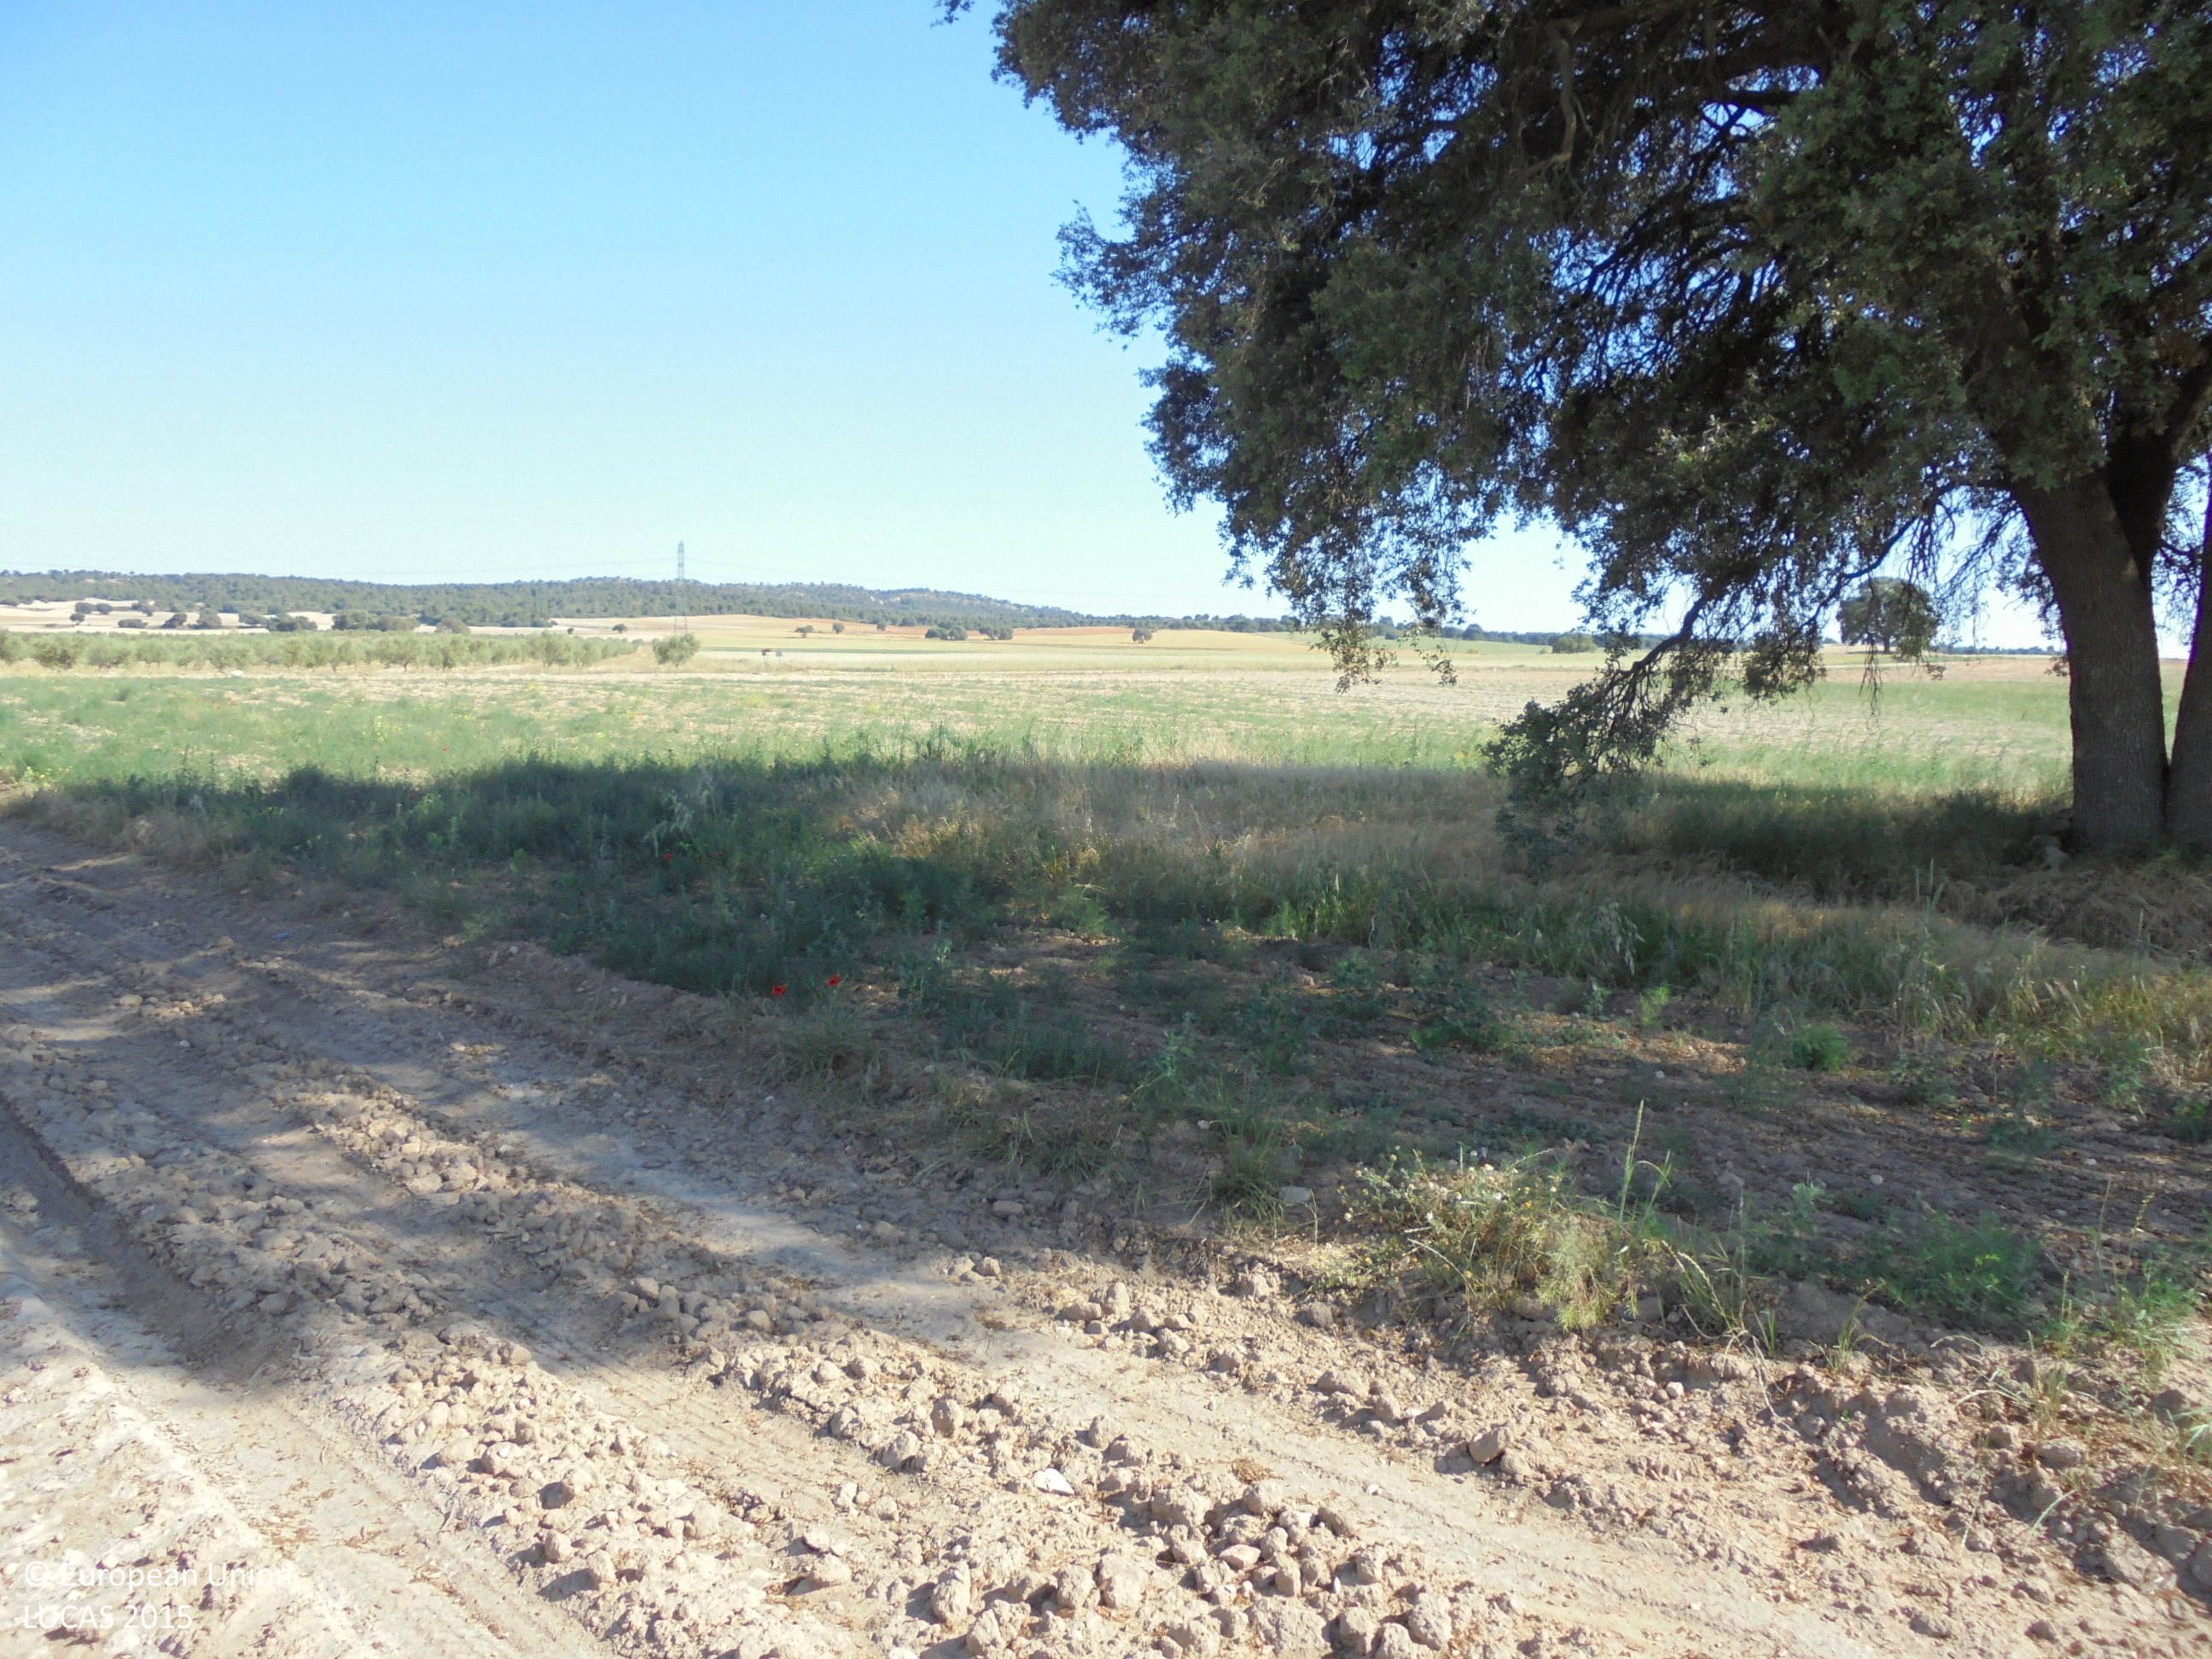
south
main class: Cropland
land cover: Vineyards
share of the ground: 10 - 25 %
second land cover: Other bare soil
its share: > 75 %
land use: Agriculture (excluding fallow land and kitchen gardens)
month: June
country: ES
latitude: 38.7579
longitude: -1.7228
